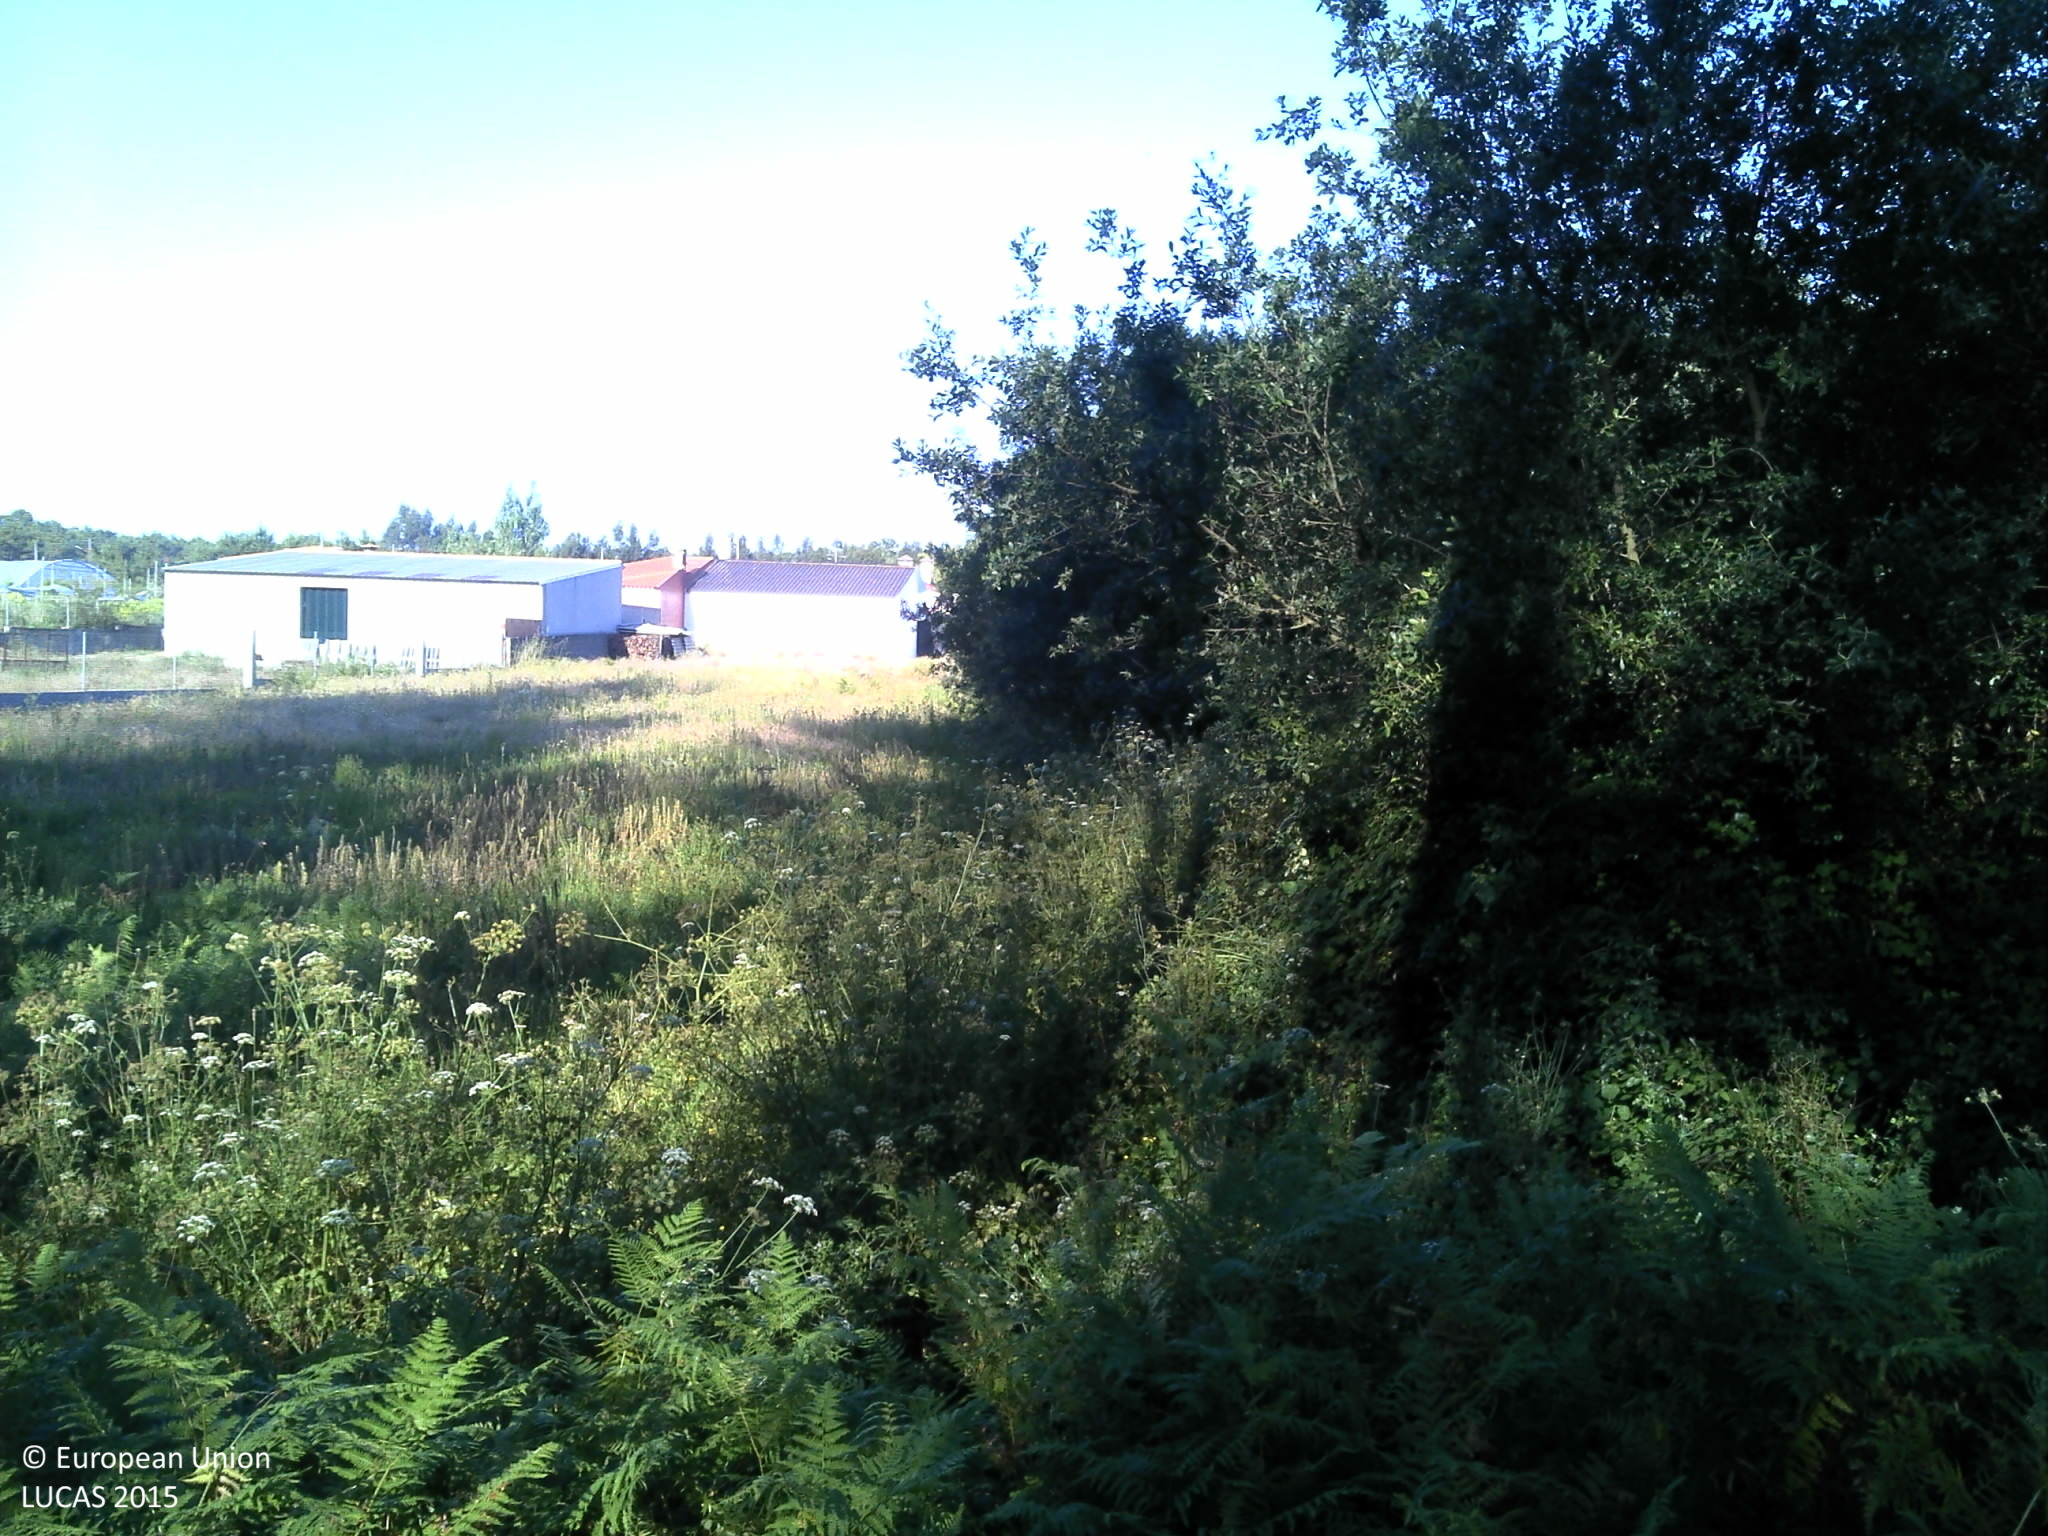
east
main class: Woodland
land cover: Pine dominated coniferous woodland
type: coniferous forest of the mediterranean region
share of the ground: 50 - 75 %
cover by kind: coniferous forest trees 75 %, shrubs 10 %, herbaceous plants 10 %, unconsolidated bare surface 5 %
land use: Forestry
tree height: > 5 m
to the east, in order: Pine dominated coniferous woodland; Ditches and canals; Spontaneously vegetated surfaces; Ditches and canals; Shrubland without tree cover; Artificial constructions in urban areas; Grass margins; Electric lines; Spontaneously vegetated surfaces; Ditches and canals; Grassland with sparse tree/shrub cover; Grassland without tree/shrub cover
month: May
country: PT
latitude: 40.4169
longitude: -8.6798
